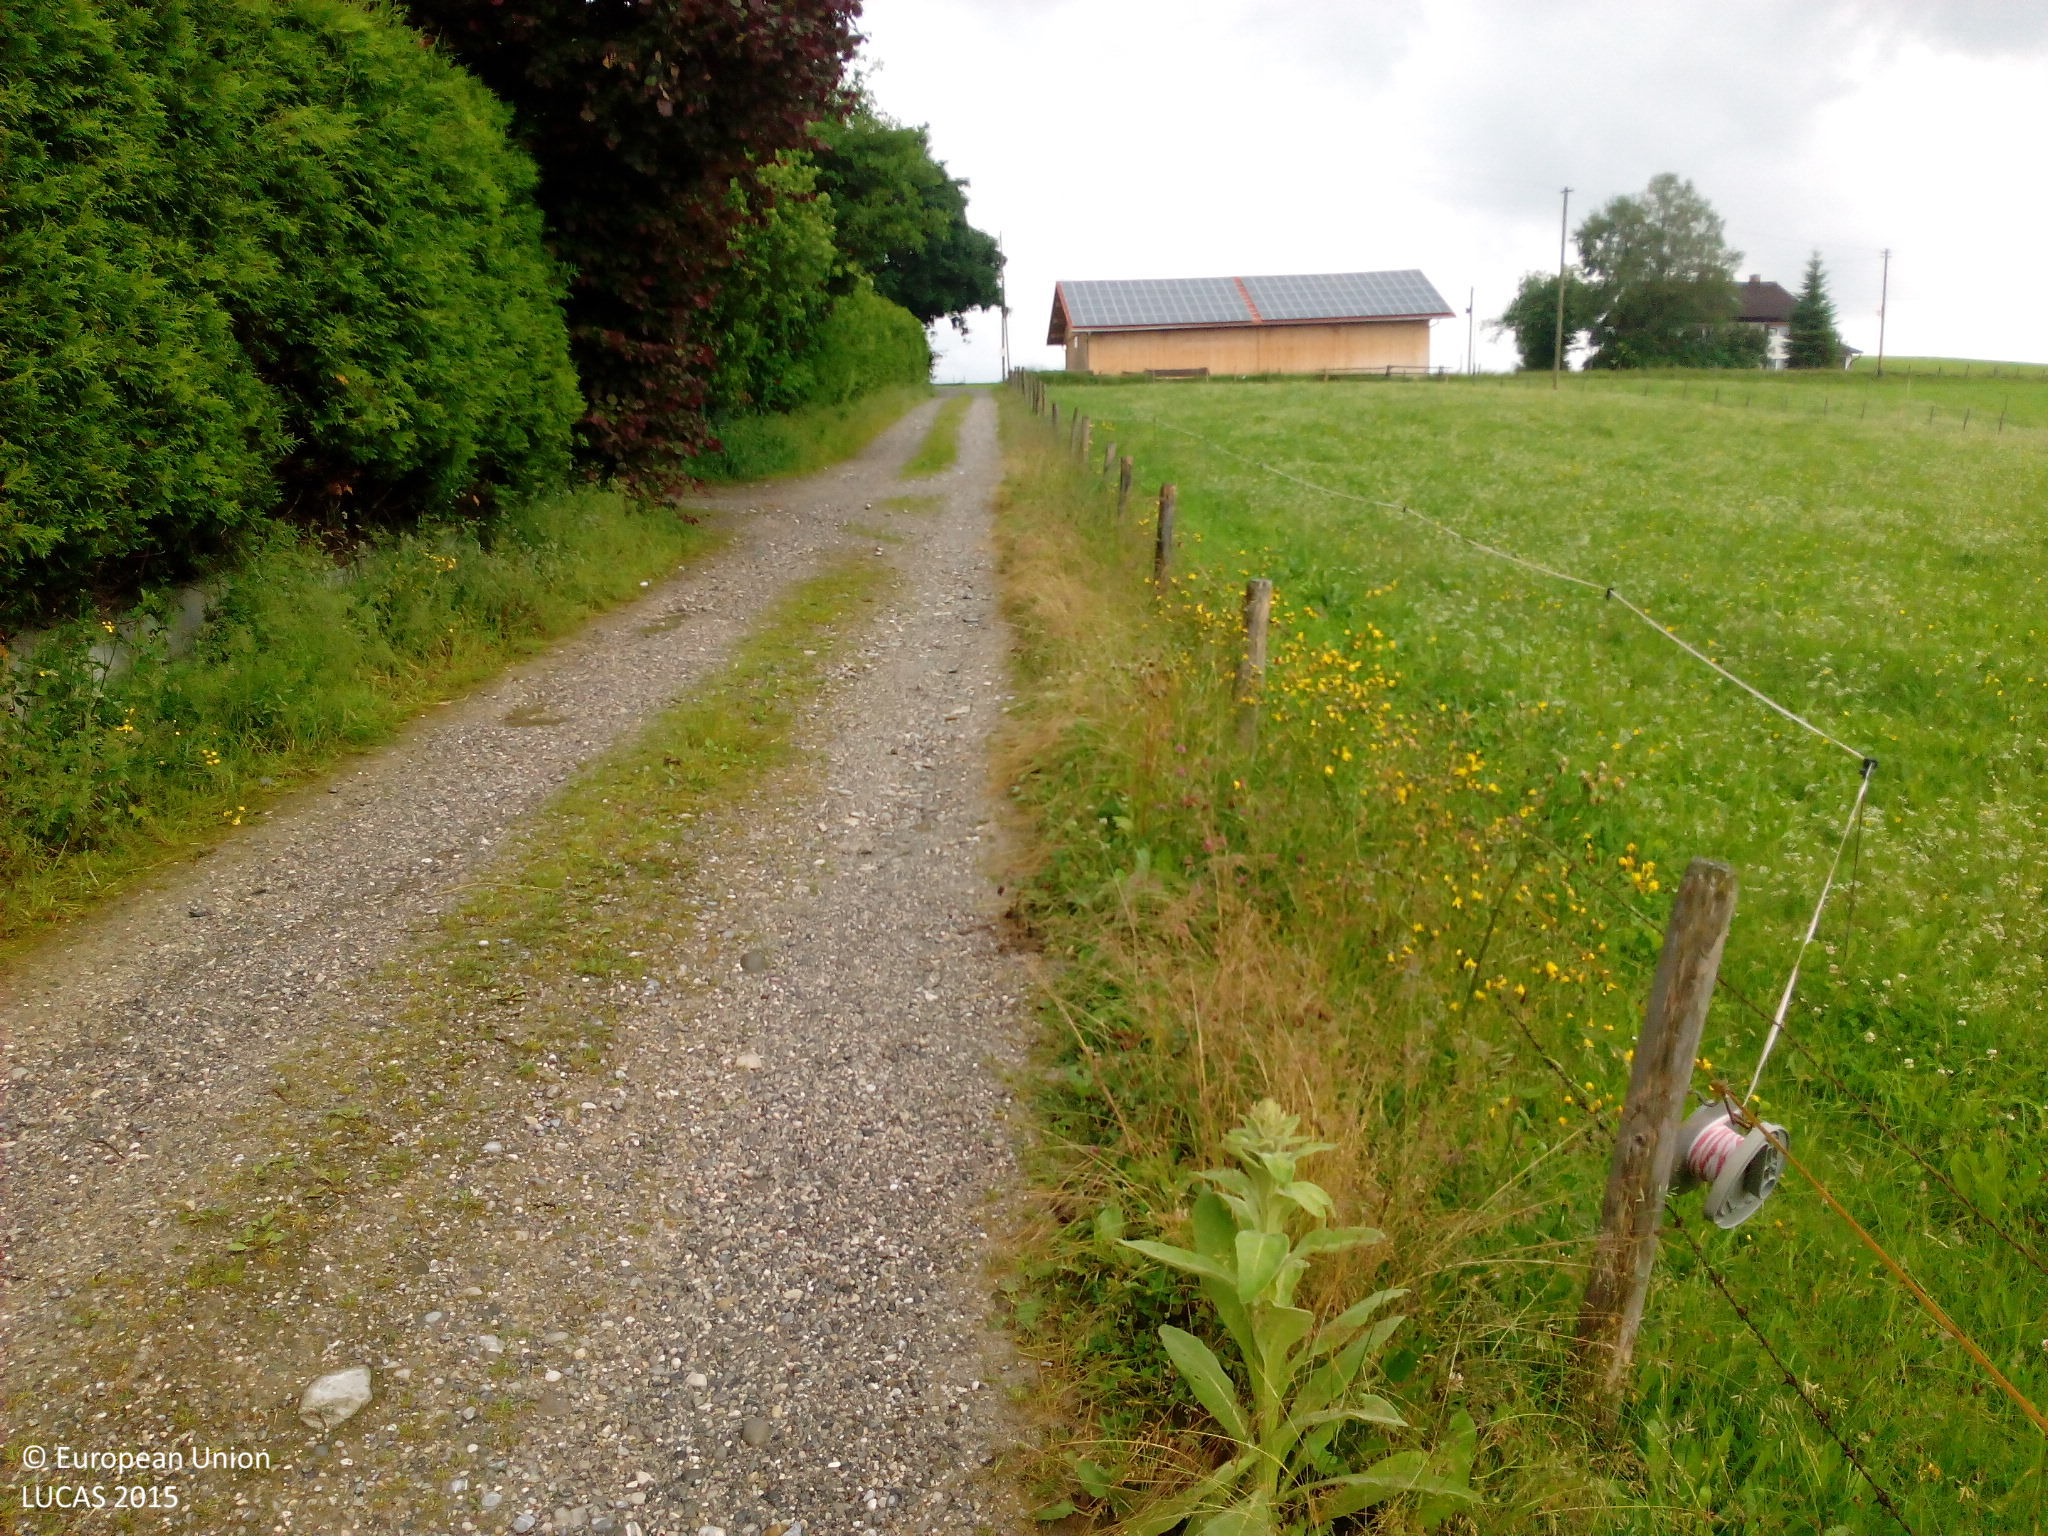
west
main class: Grassland
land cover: Grassland without tree/shrub cover
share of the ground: > 75 %
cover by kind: herbaceous plants 100 %
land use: Agriculture (excluding fallow land and kitchen gardens)
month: June
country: DE
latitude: 47.7000
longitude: 10.5992
